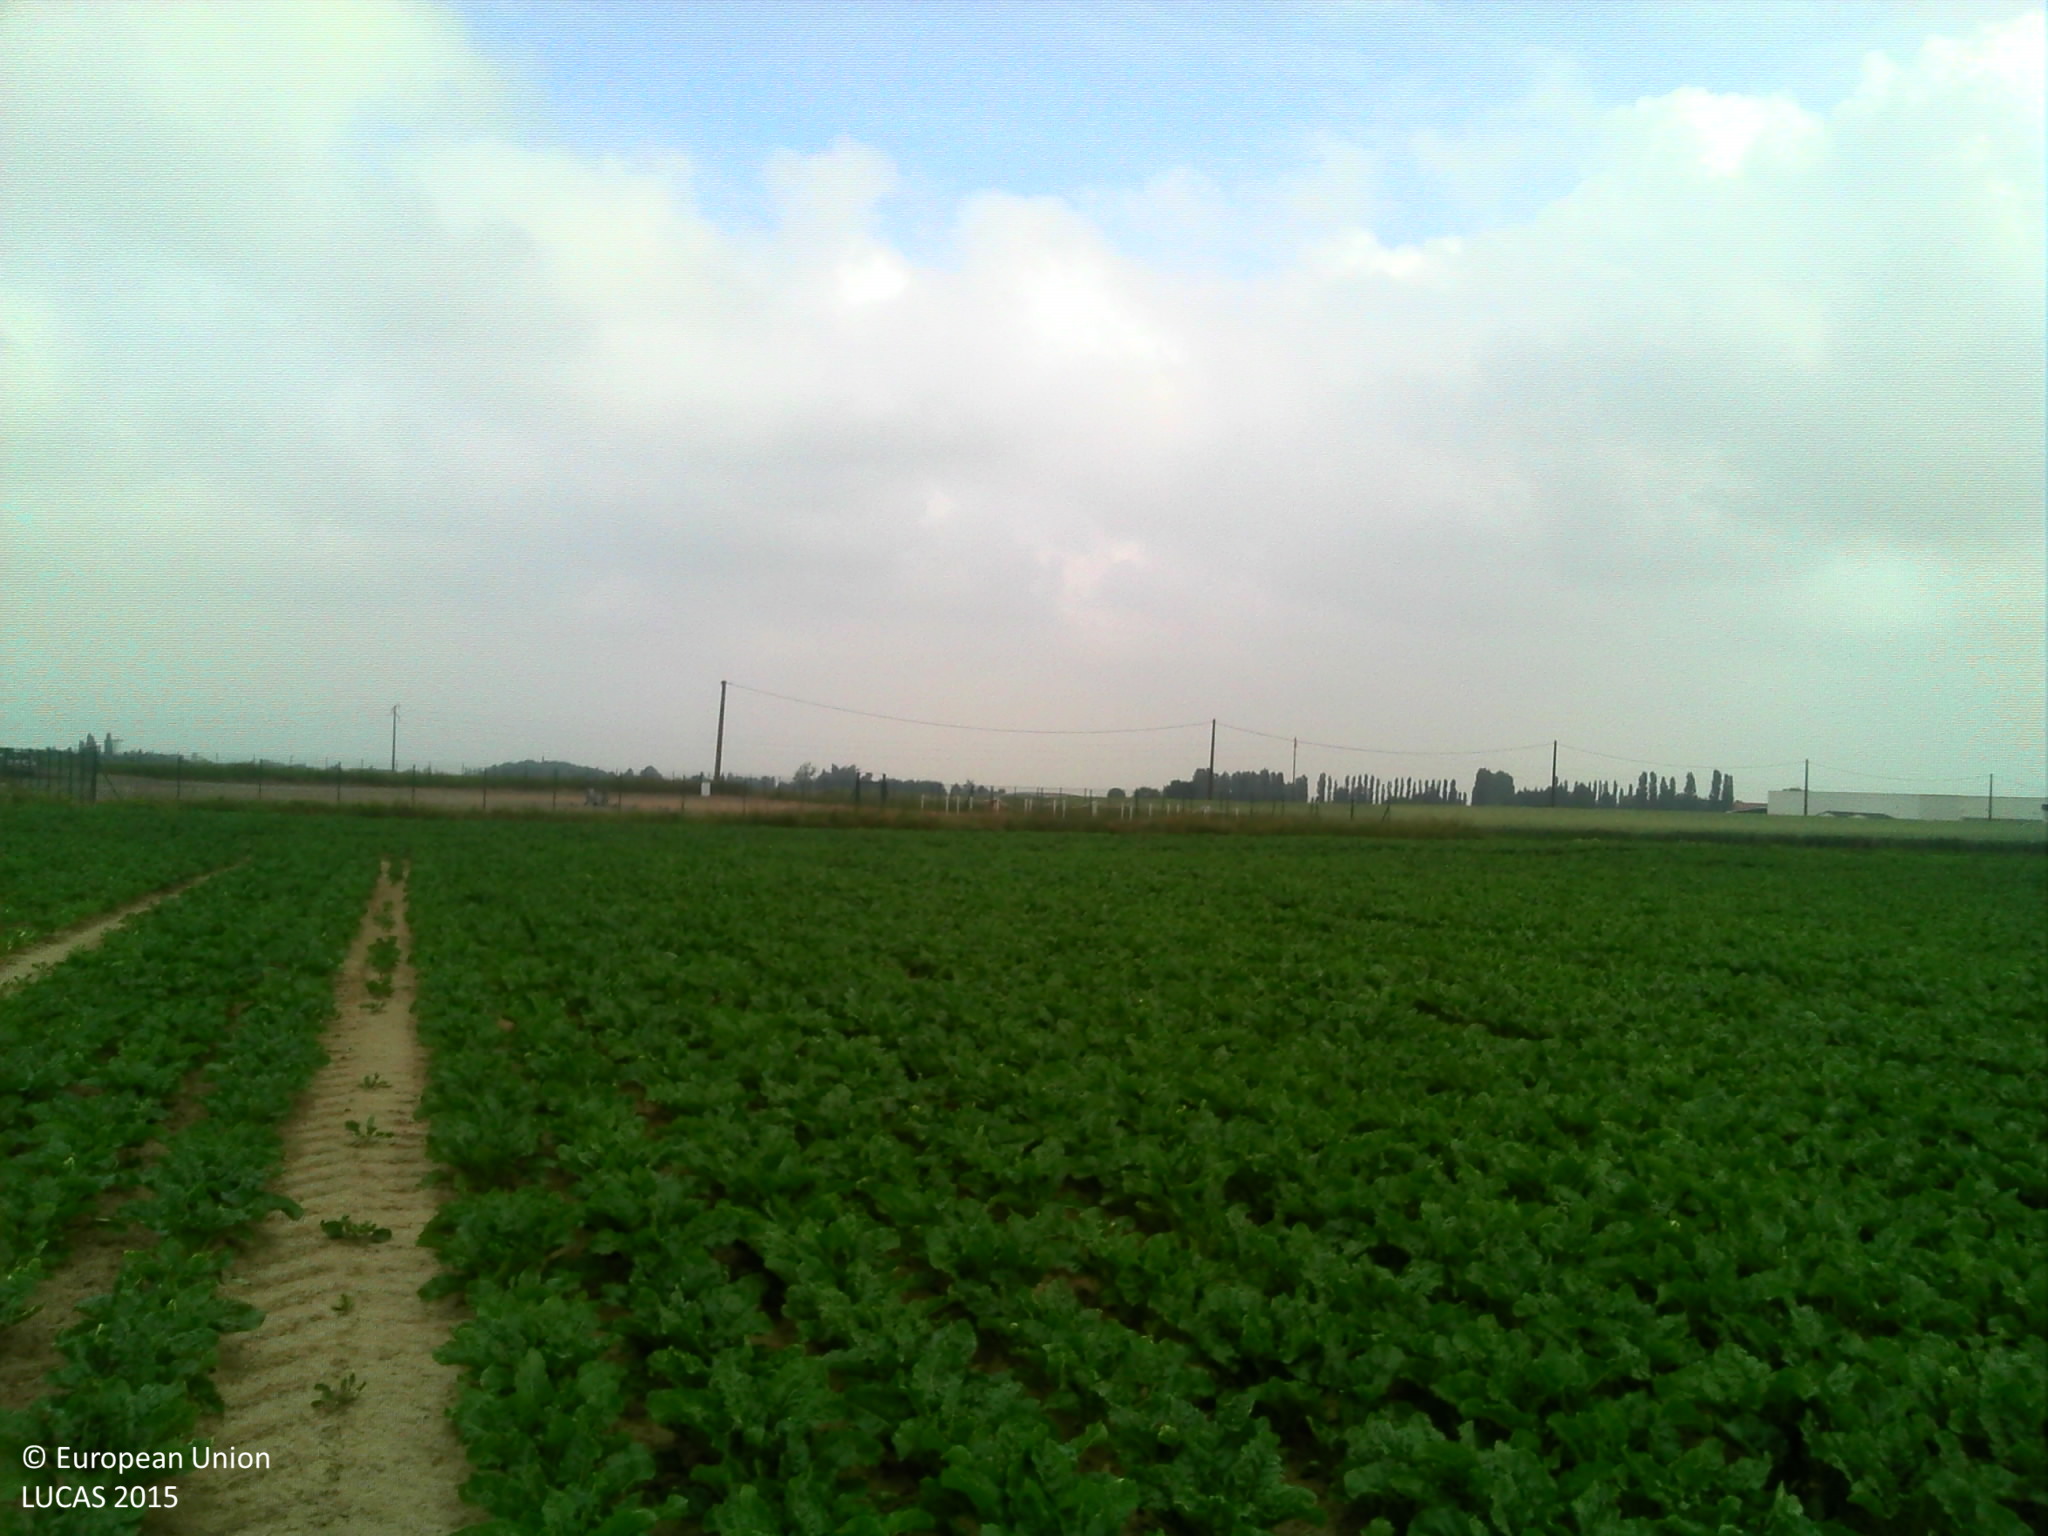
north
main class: Cropland
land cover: Sugar beet
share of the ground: > 75 %
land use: Agriculture (excluding fallow land and kitchen gardens)
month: June
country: FR
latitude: 49.5459
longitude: 2.5942
